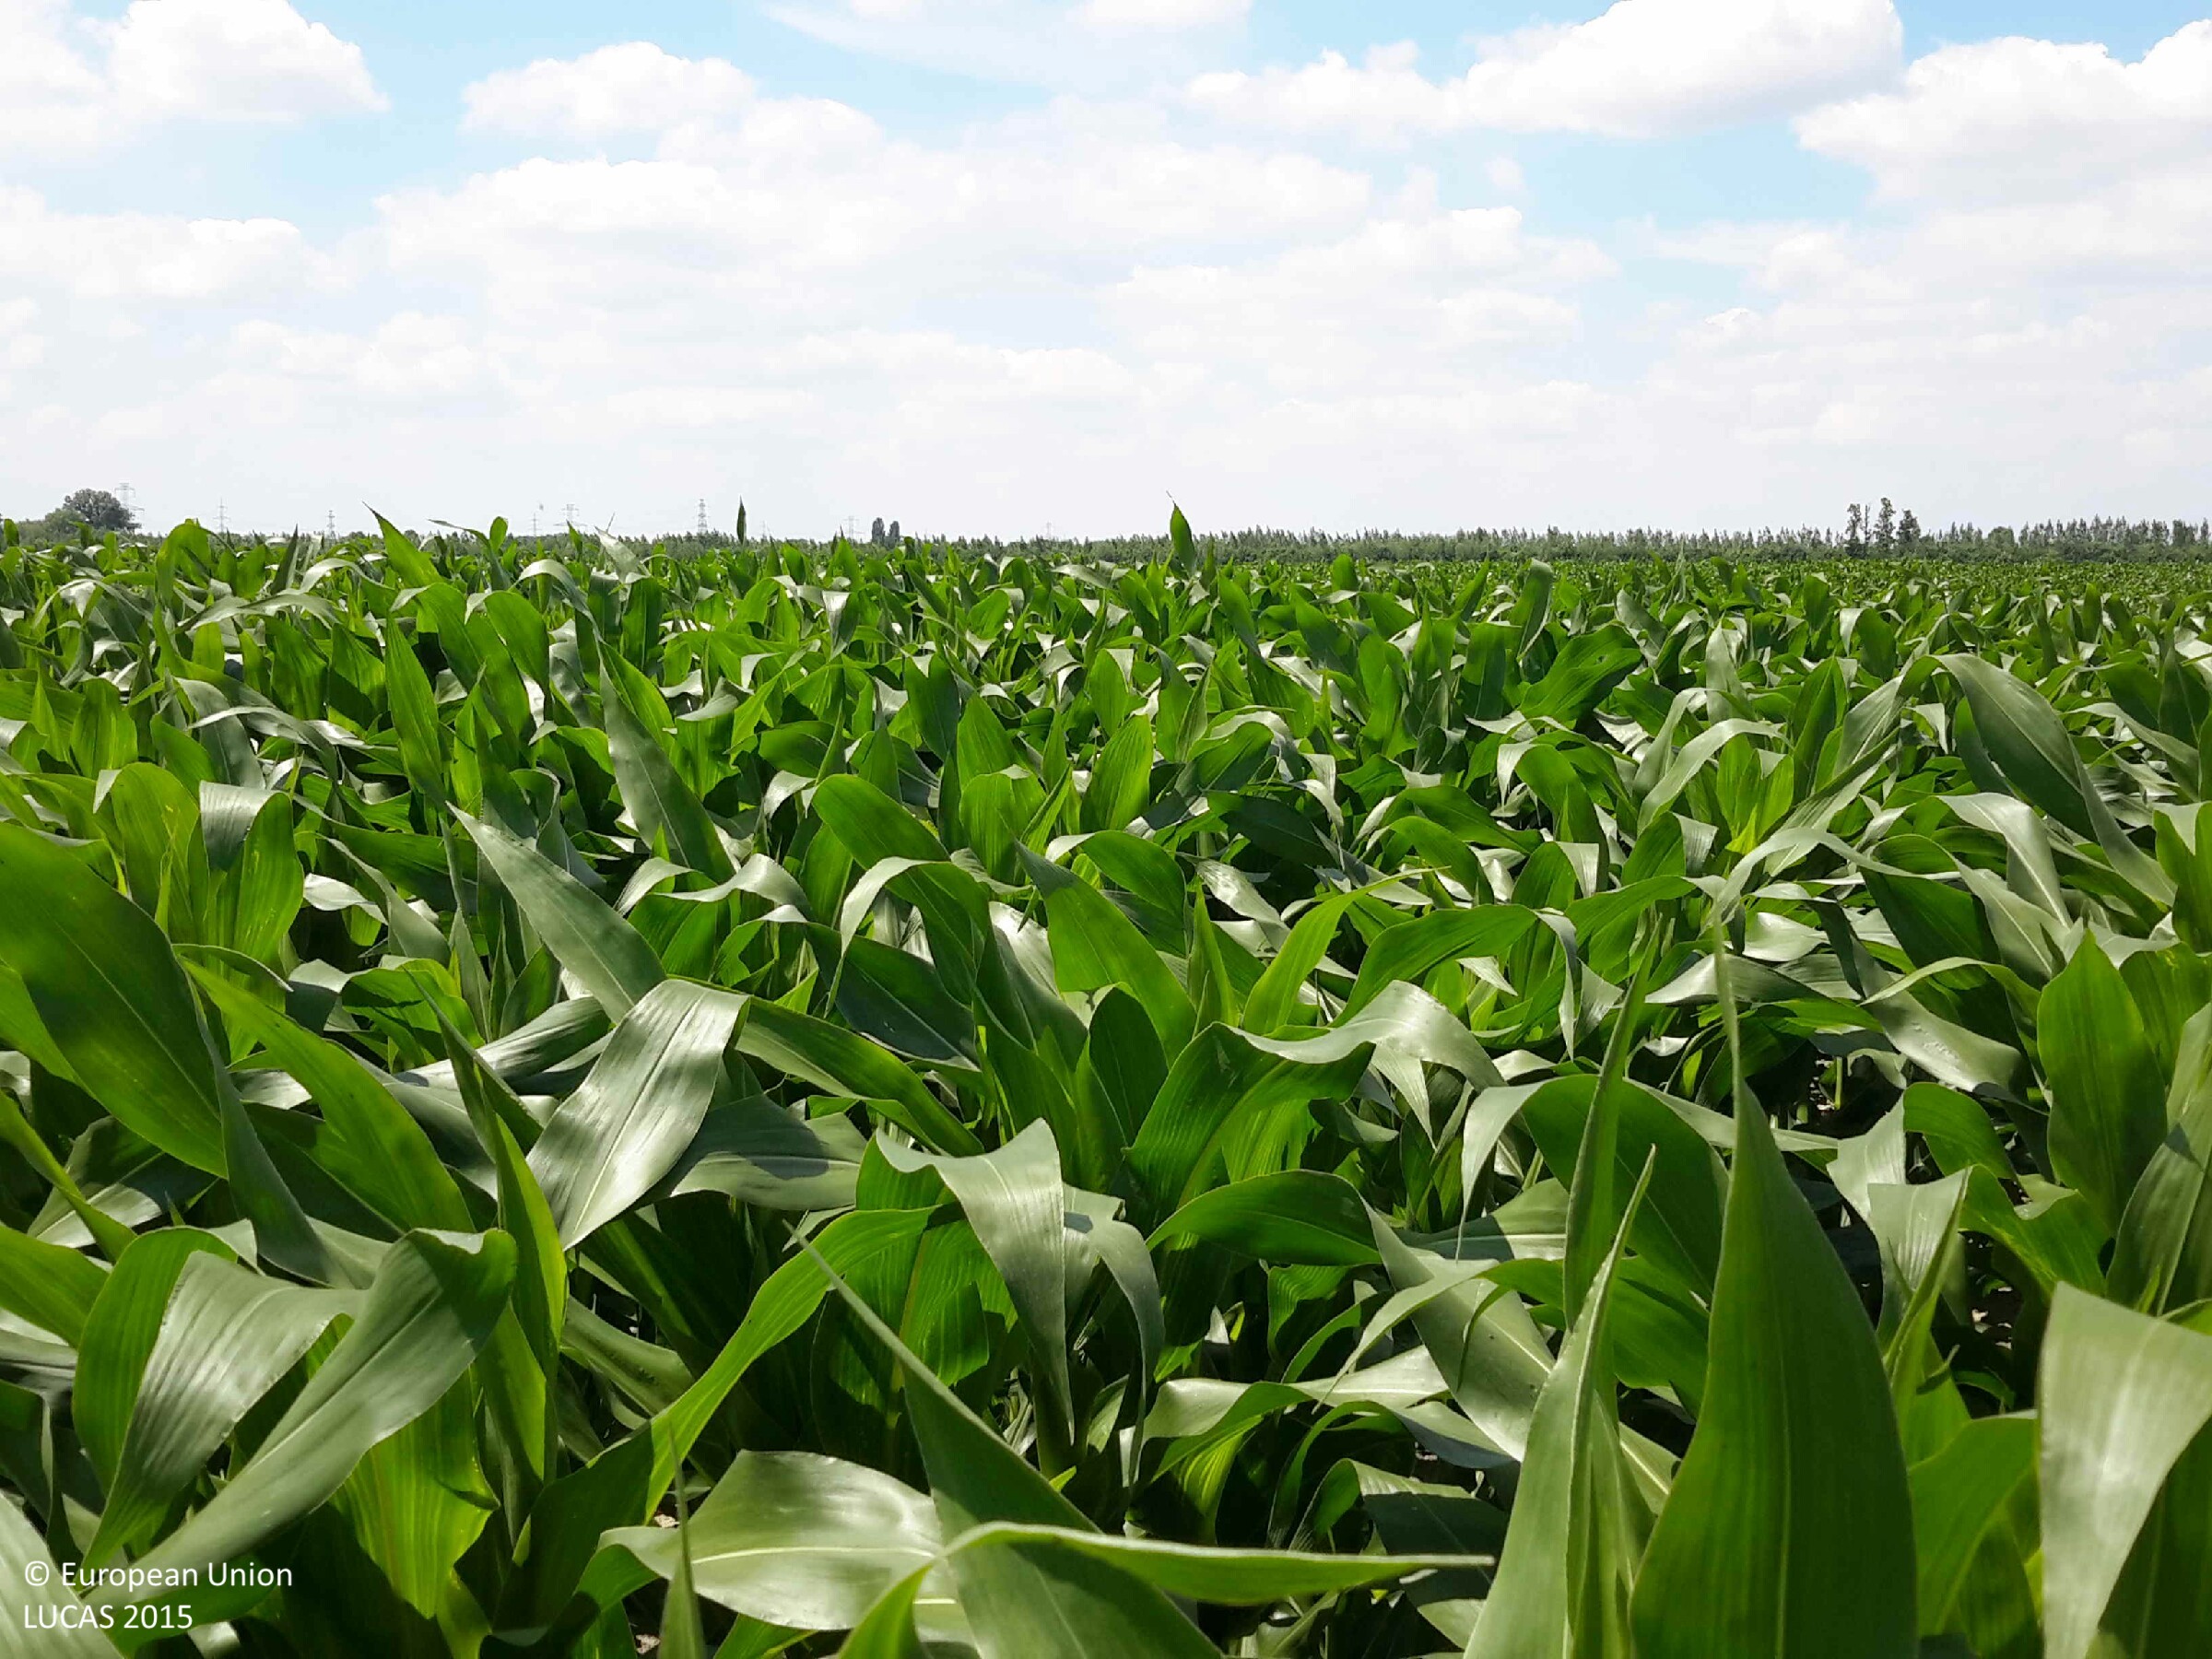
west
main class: Cropland
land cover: Maize
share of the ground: > 75 %
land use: Agriculture (excluding fallow land and kitchen gardens)
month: June
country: HU
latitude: 47.7140
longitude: 17.5131
